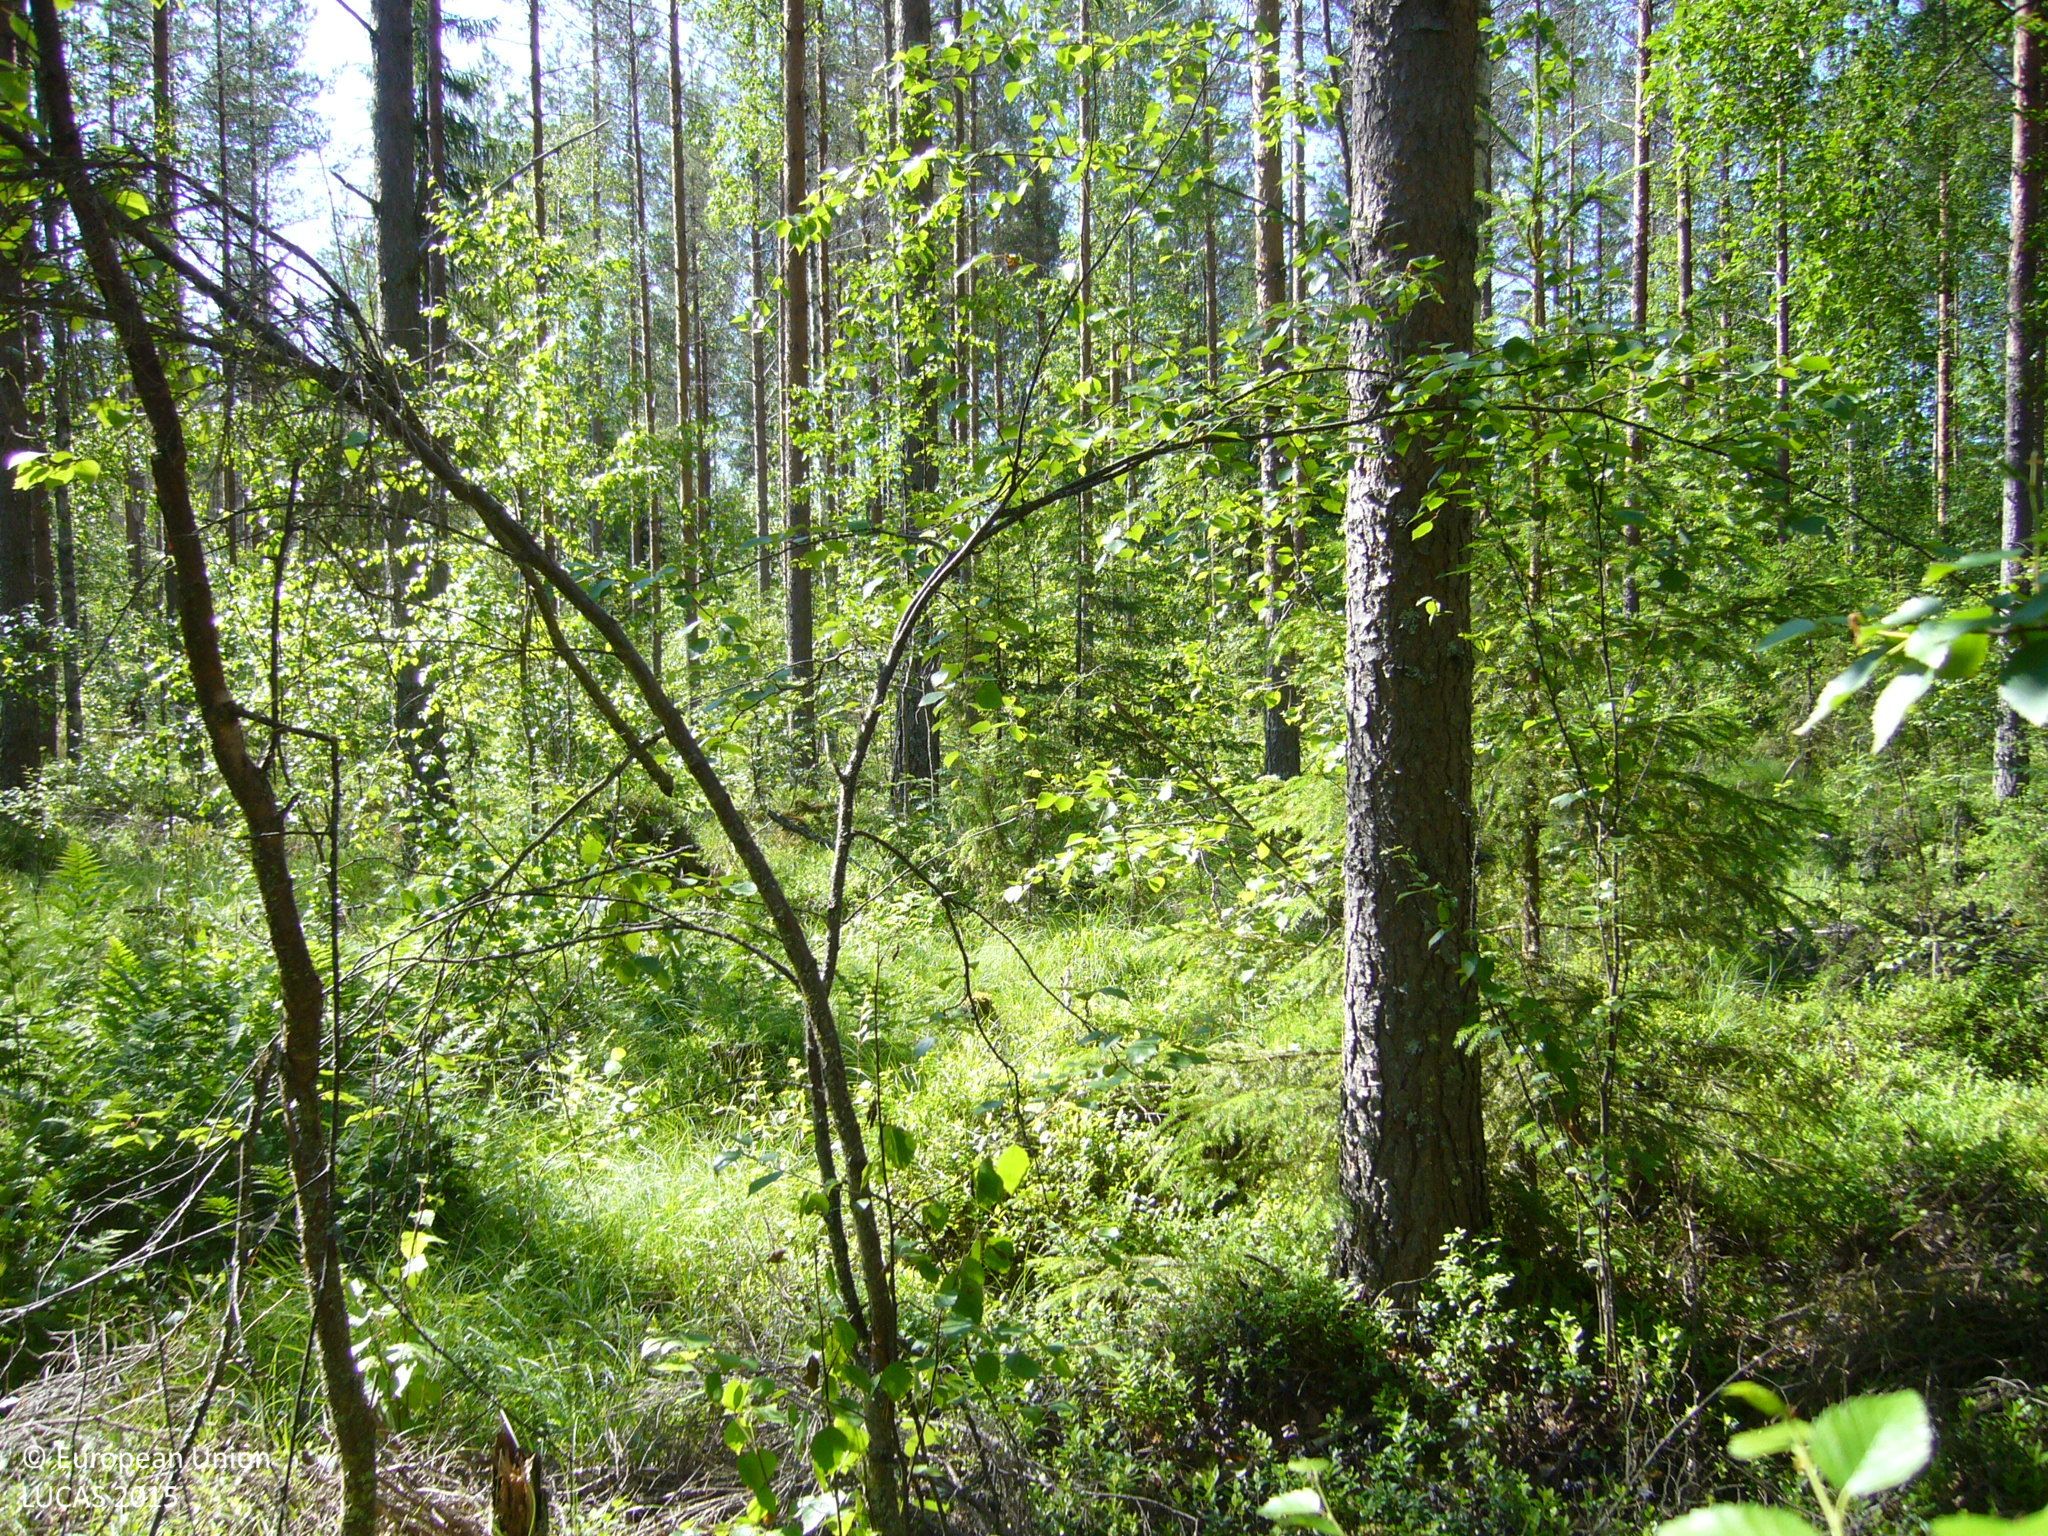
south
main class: Woodland
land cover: Pine dominated coniferous woodland
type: boreal forest
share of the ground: 50 - 75 %
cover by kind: coniferous forest trees 60 %, shrubs 30 %, broadleaved forest trees 10 %
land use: Forestry
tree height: > 5 m
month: July
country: FI
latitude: 63.3545
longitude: 25.8404
